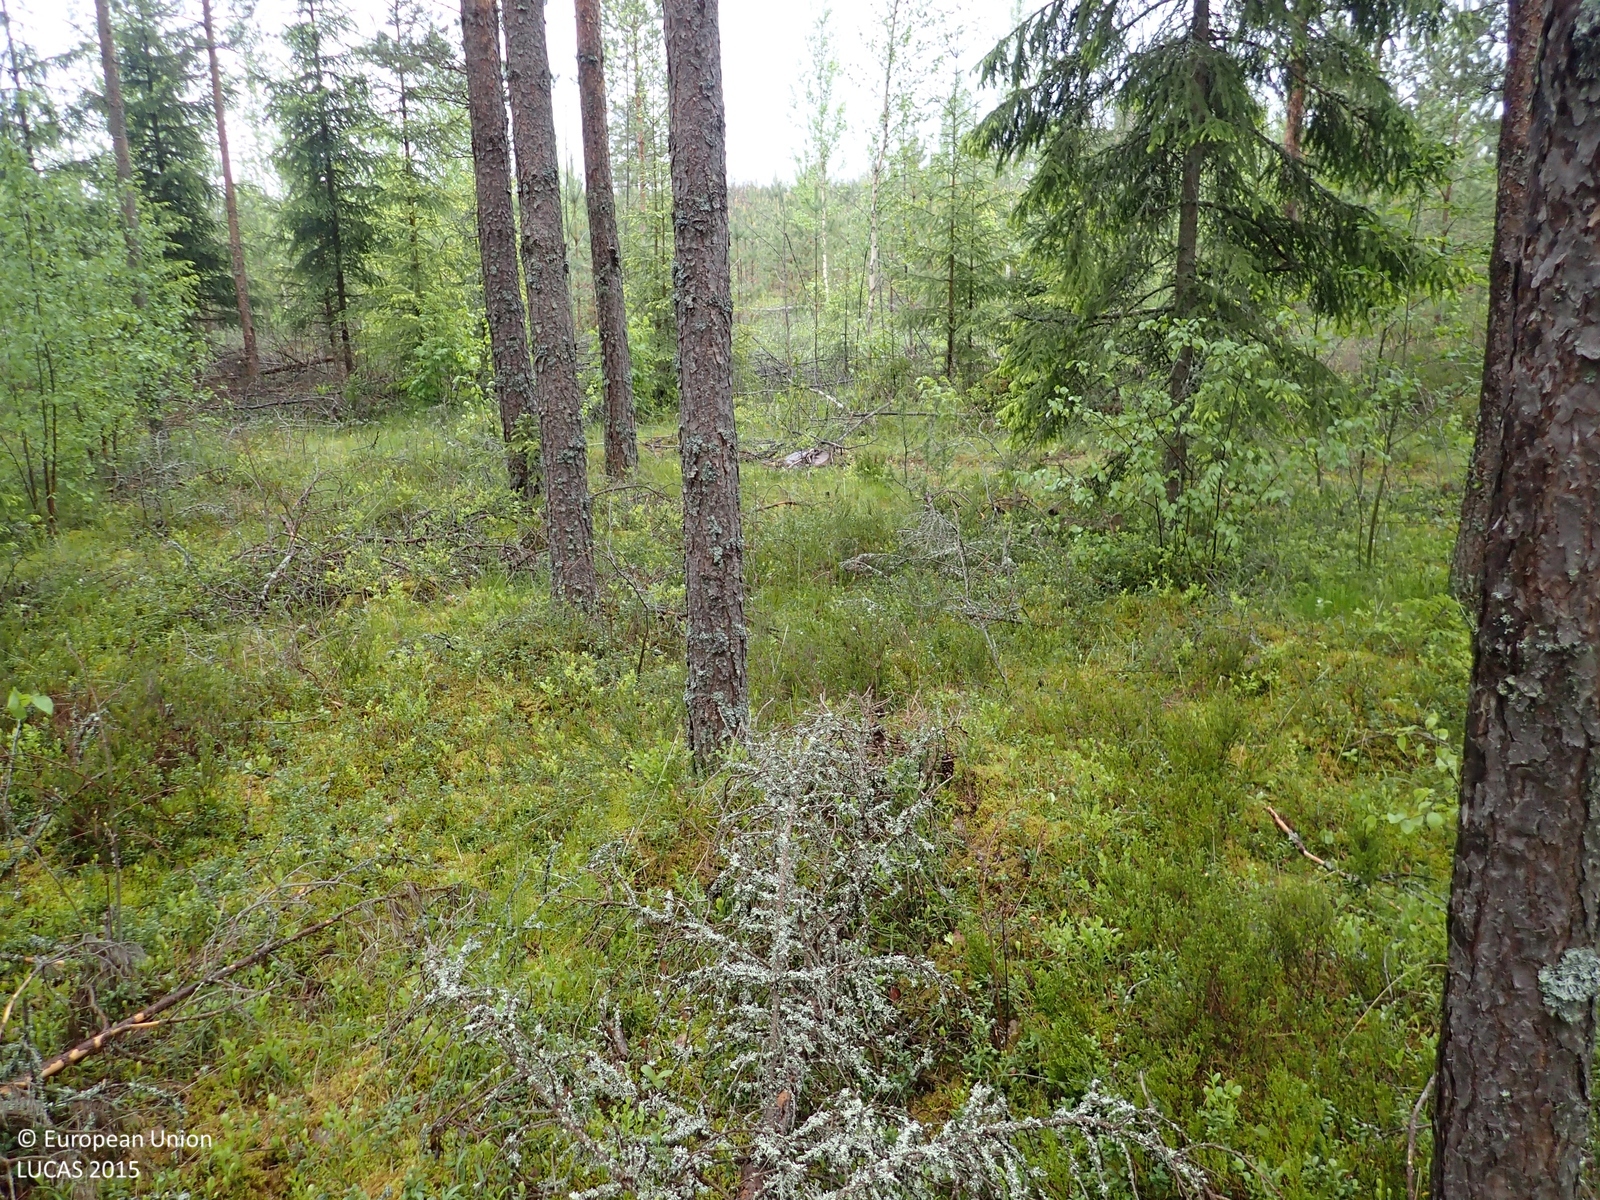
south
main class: Woodland
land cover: Pine dominated coniferous woodland
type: boreal forest
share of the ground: > 75 %
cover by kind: coniferous forest trees 65 %, shrubs 15 %, broadleaved forest trees 10 %, herbaceous plants 5 %, lichens and mosses 5 %
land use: Forestry
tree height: > 5 m
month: June
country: FI
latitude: 62.1785
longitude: 21.6285
